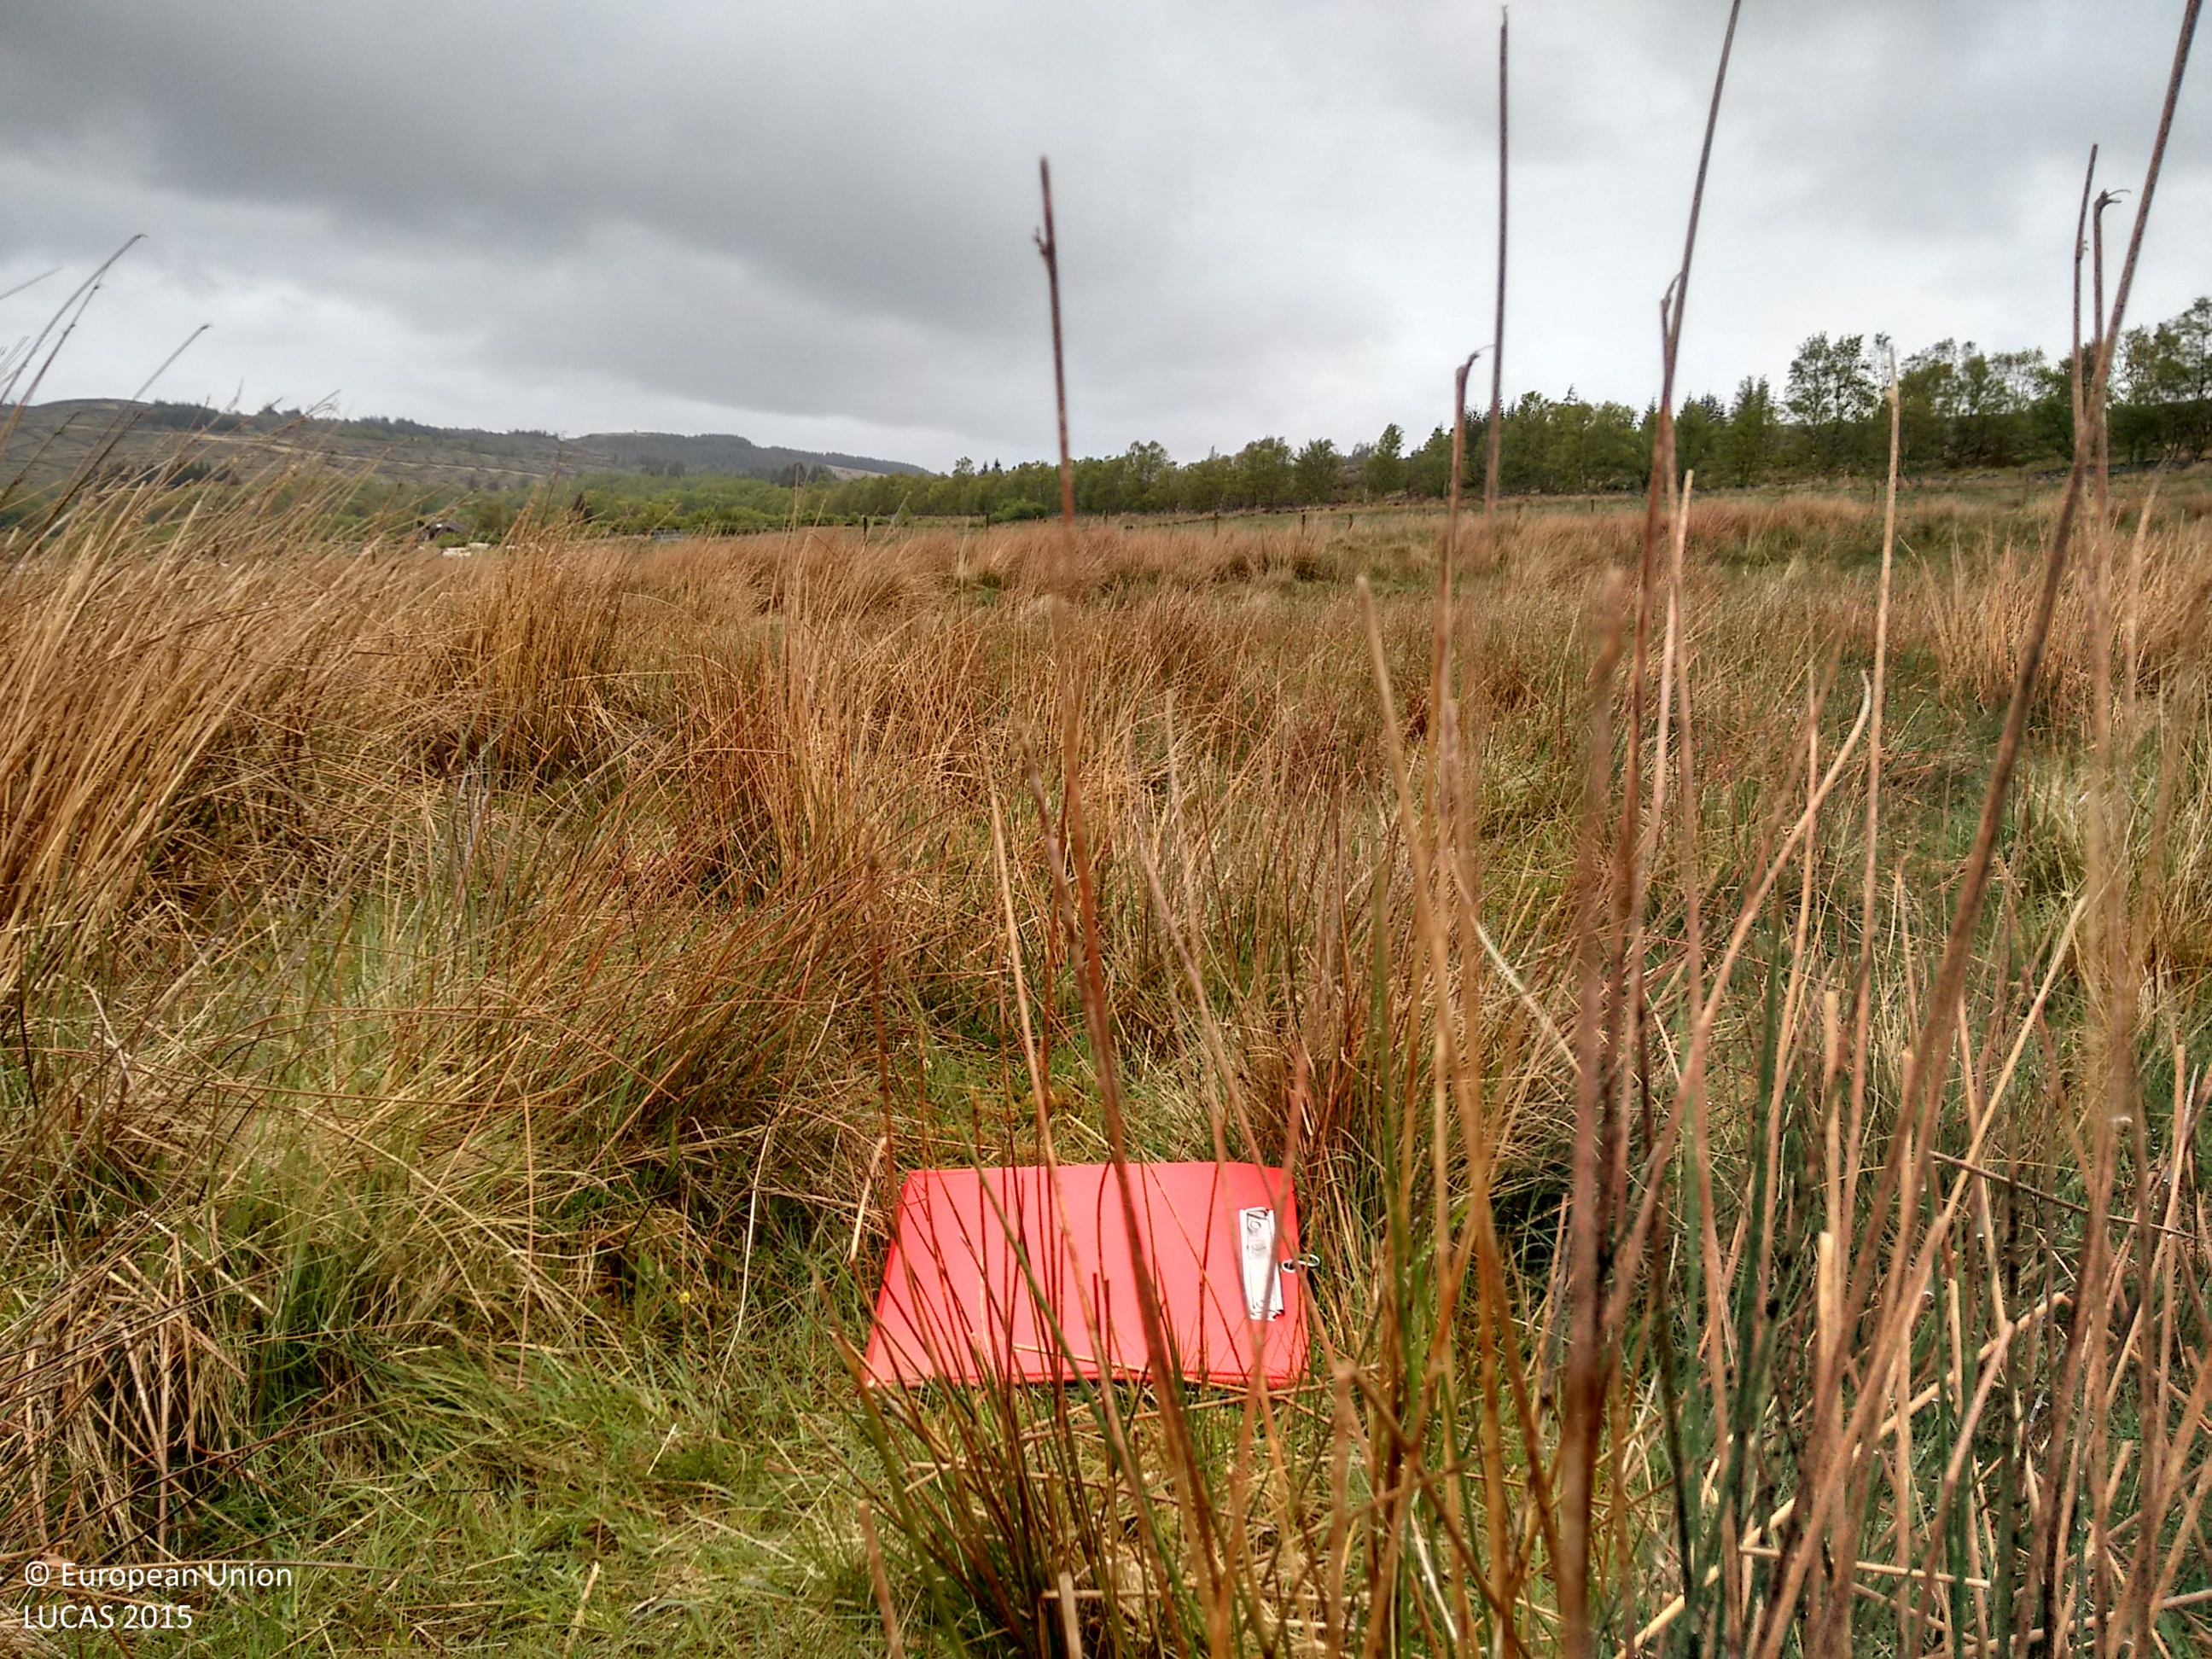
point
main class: Grassland
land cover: Grassland without tree/shrub cover
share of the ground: > 75 %
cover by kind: herbaceous plants 100 %
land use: Agriculture (excluding fallow land and kitchen gardens)
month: May
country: GB
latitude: 56.0308
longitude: -4.8539
